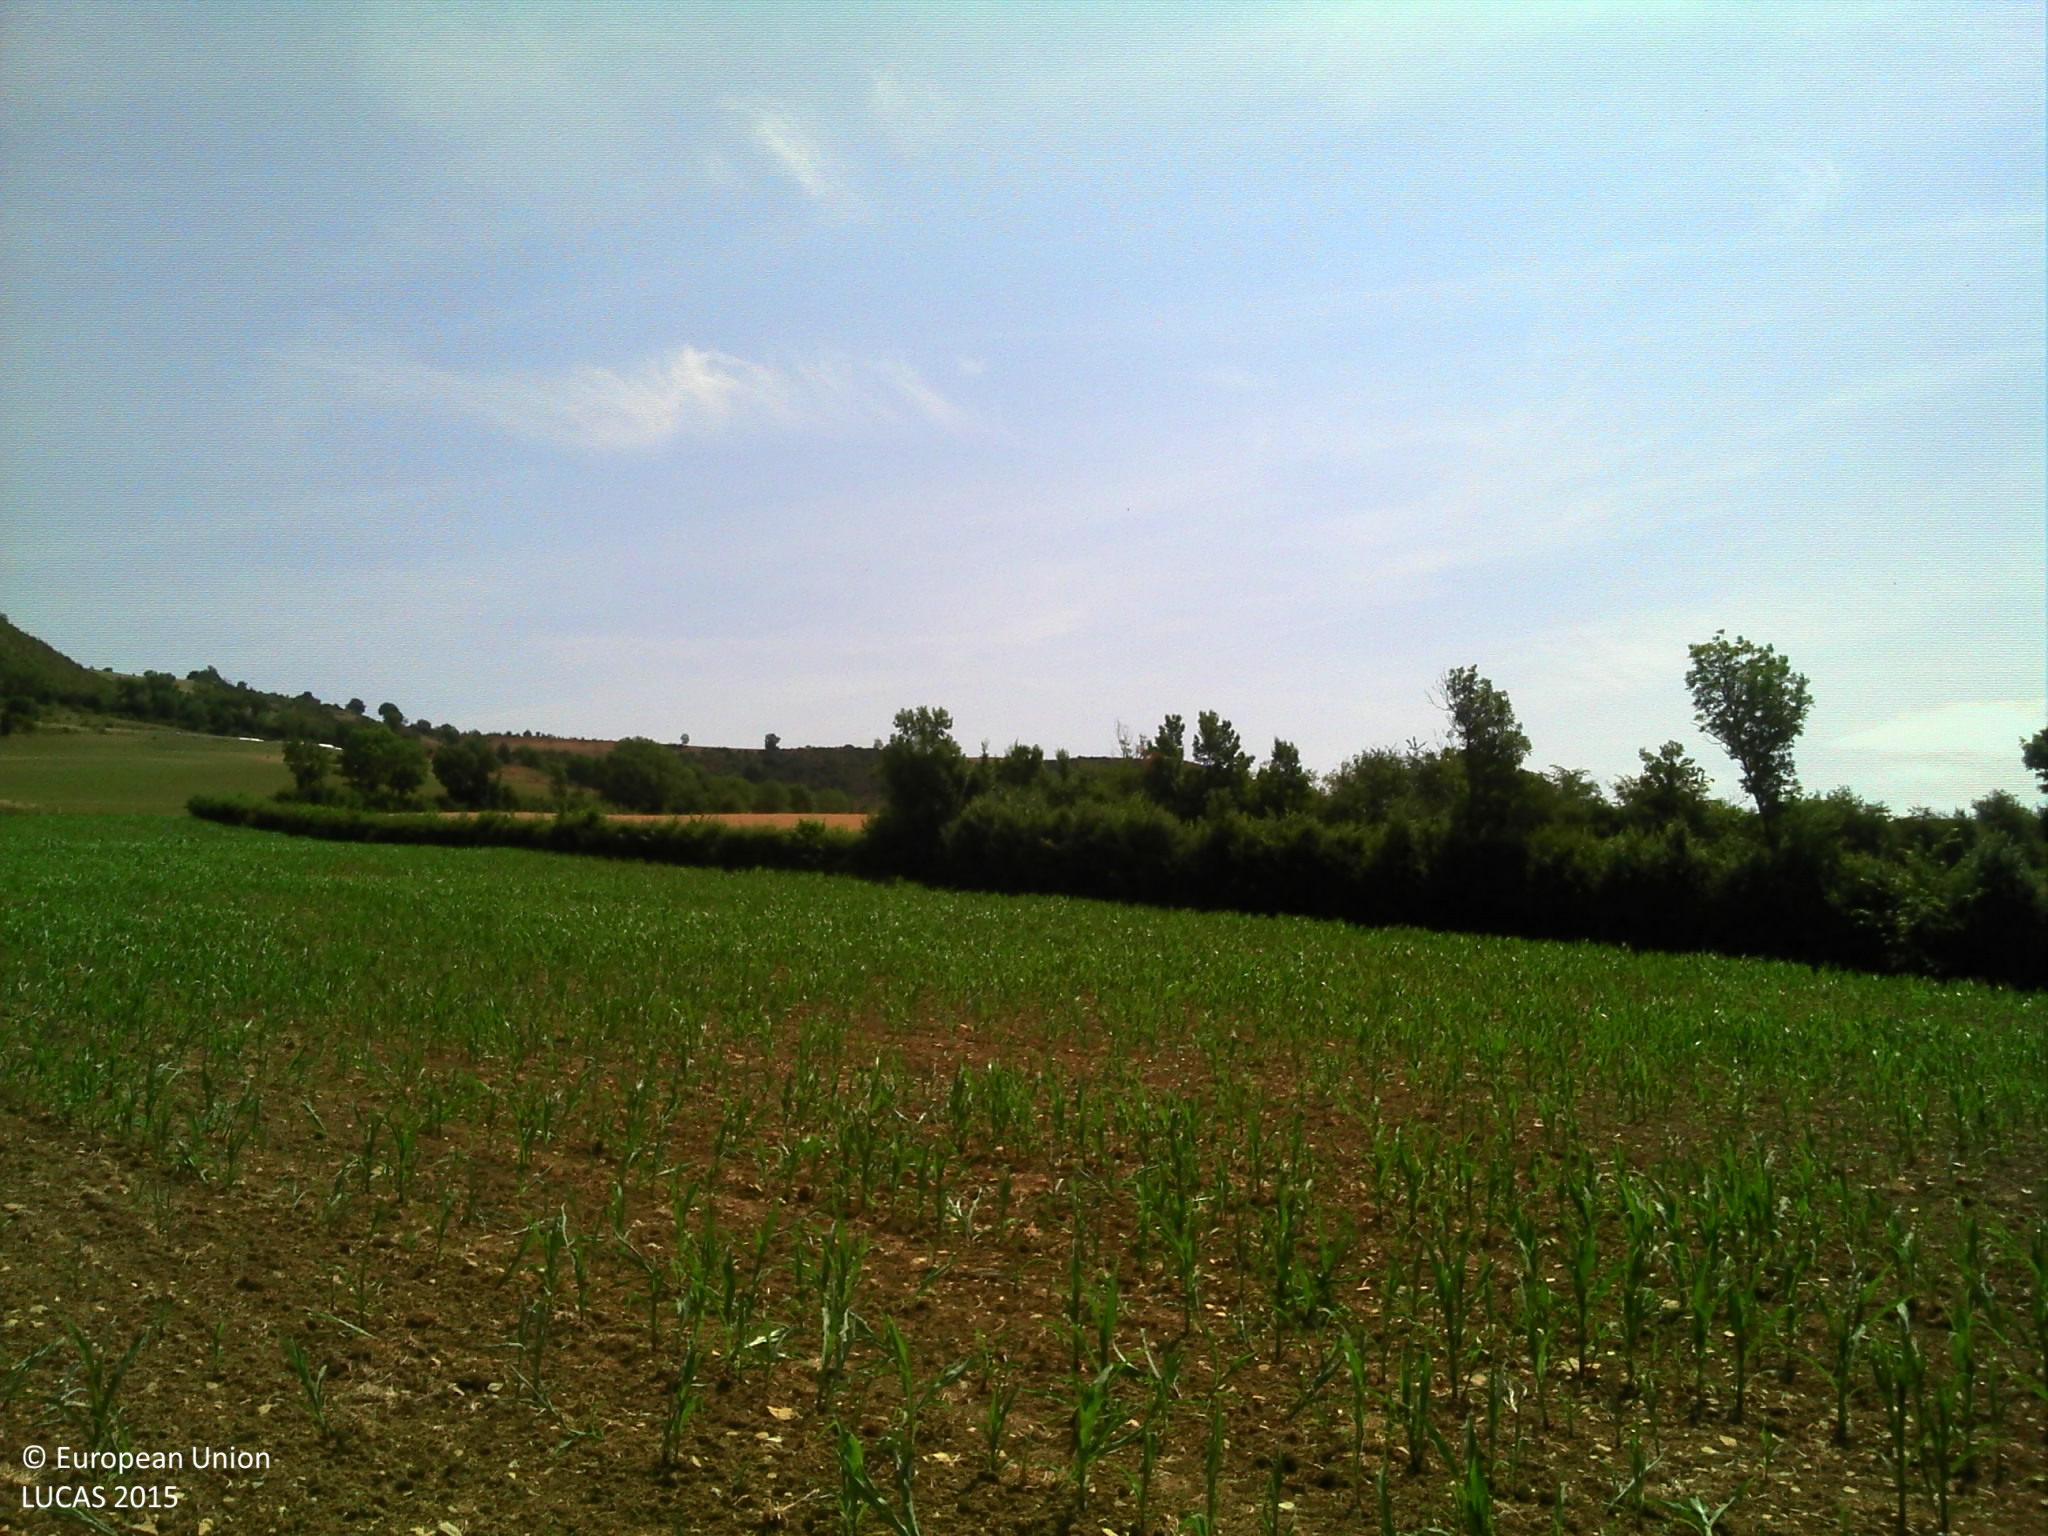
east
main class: Cropland
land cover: Maize
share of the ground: 50 - 75 %
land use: Agriculture (excluding fallow land and kitchen gardens)
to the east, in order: Maize; Managed hedges; Common wheat
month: July
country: FR
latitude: 44.5122
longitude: 3.2746
